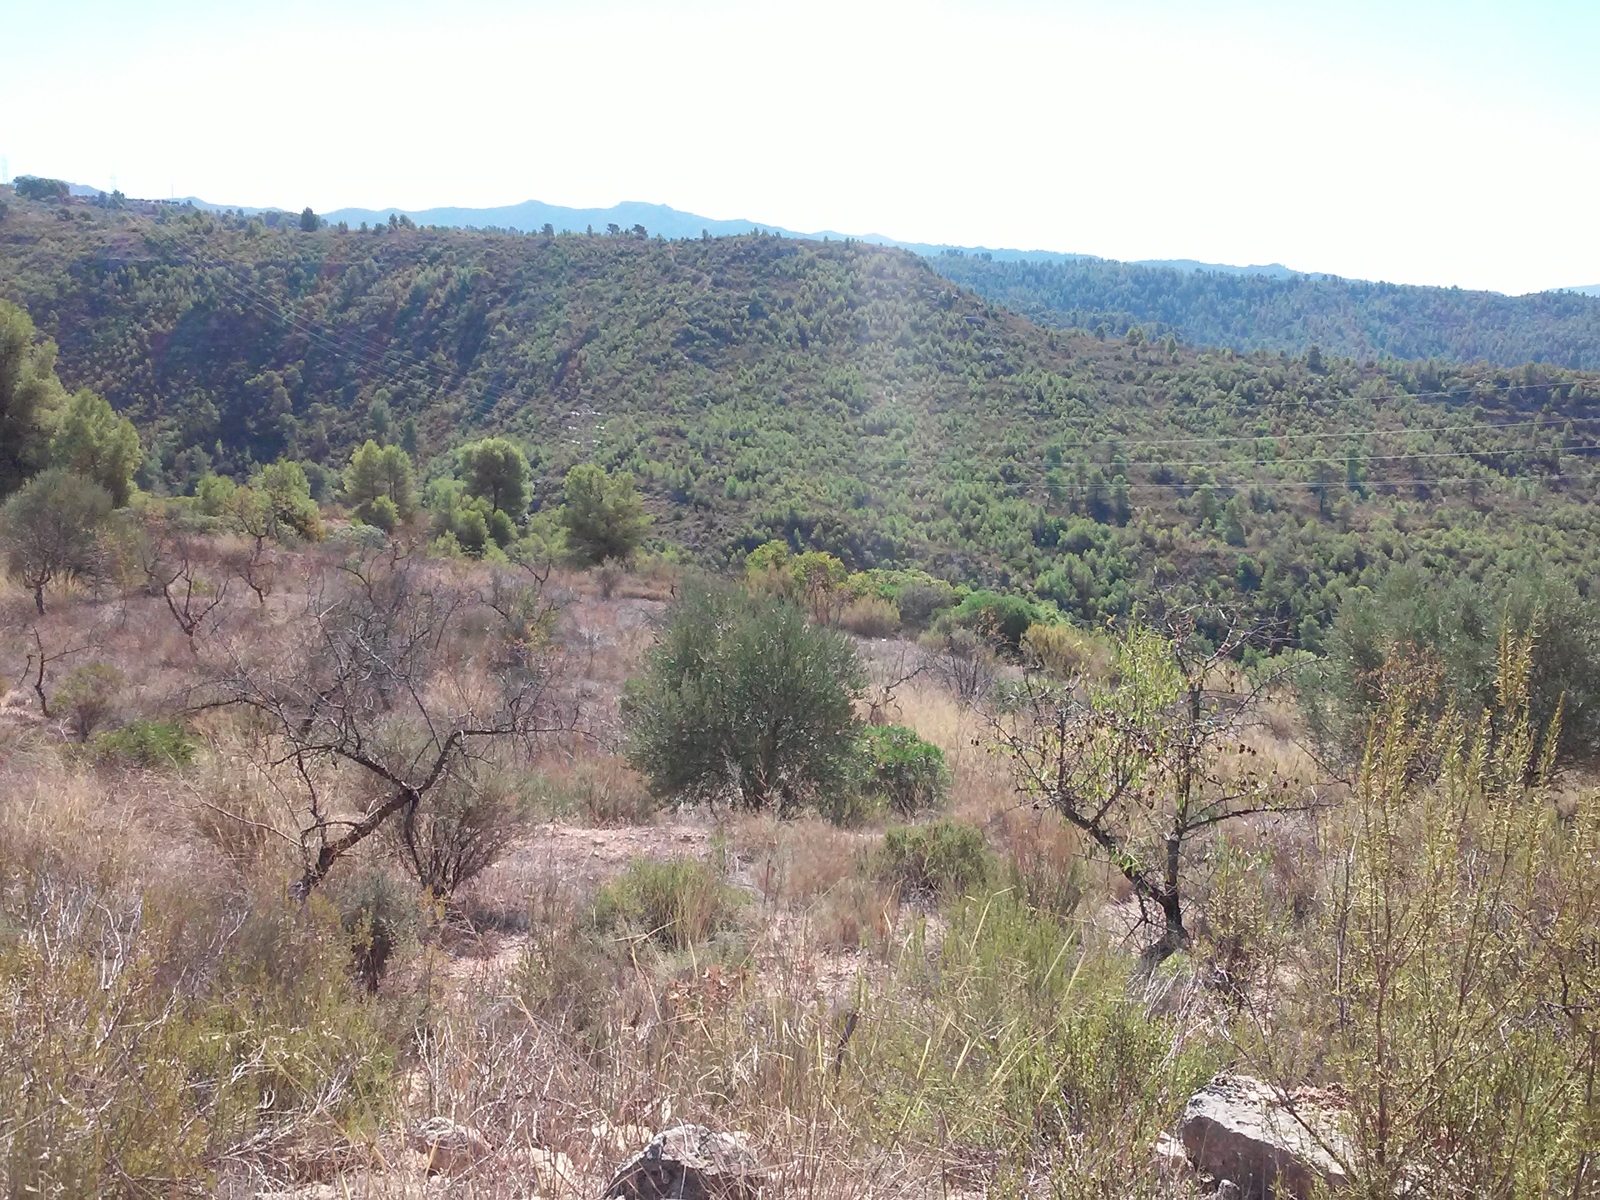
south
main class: Cropland
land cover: Nuts trees
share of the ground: 10 - 25 %
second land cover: Grassland without tree/shrub cover
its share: > 75 %
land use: Abandoned areas
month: September
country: ES
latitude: 41.2165
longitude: 0.6038
